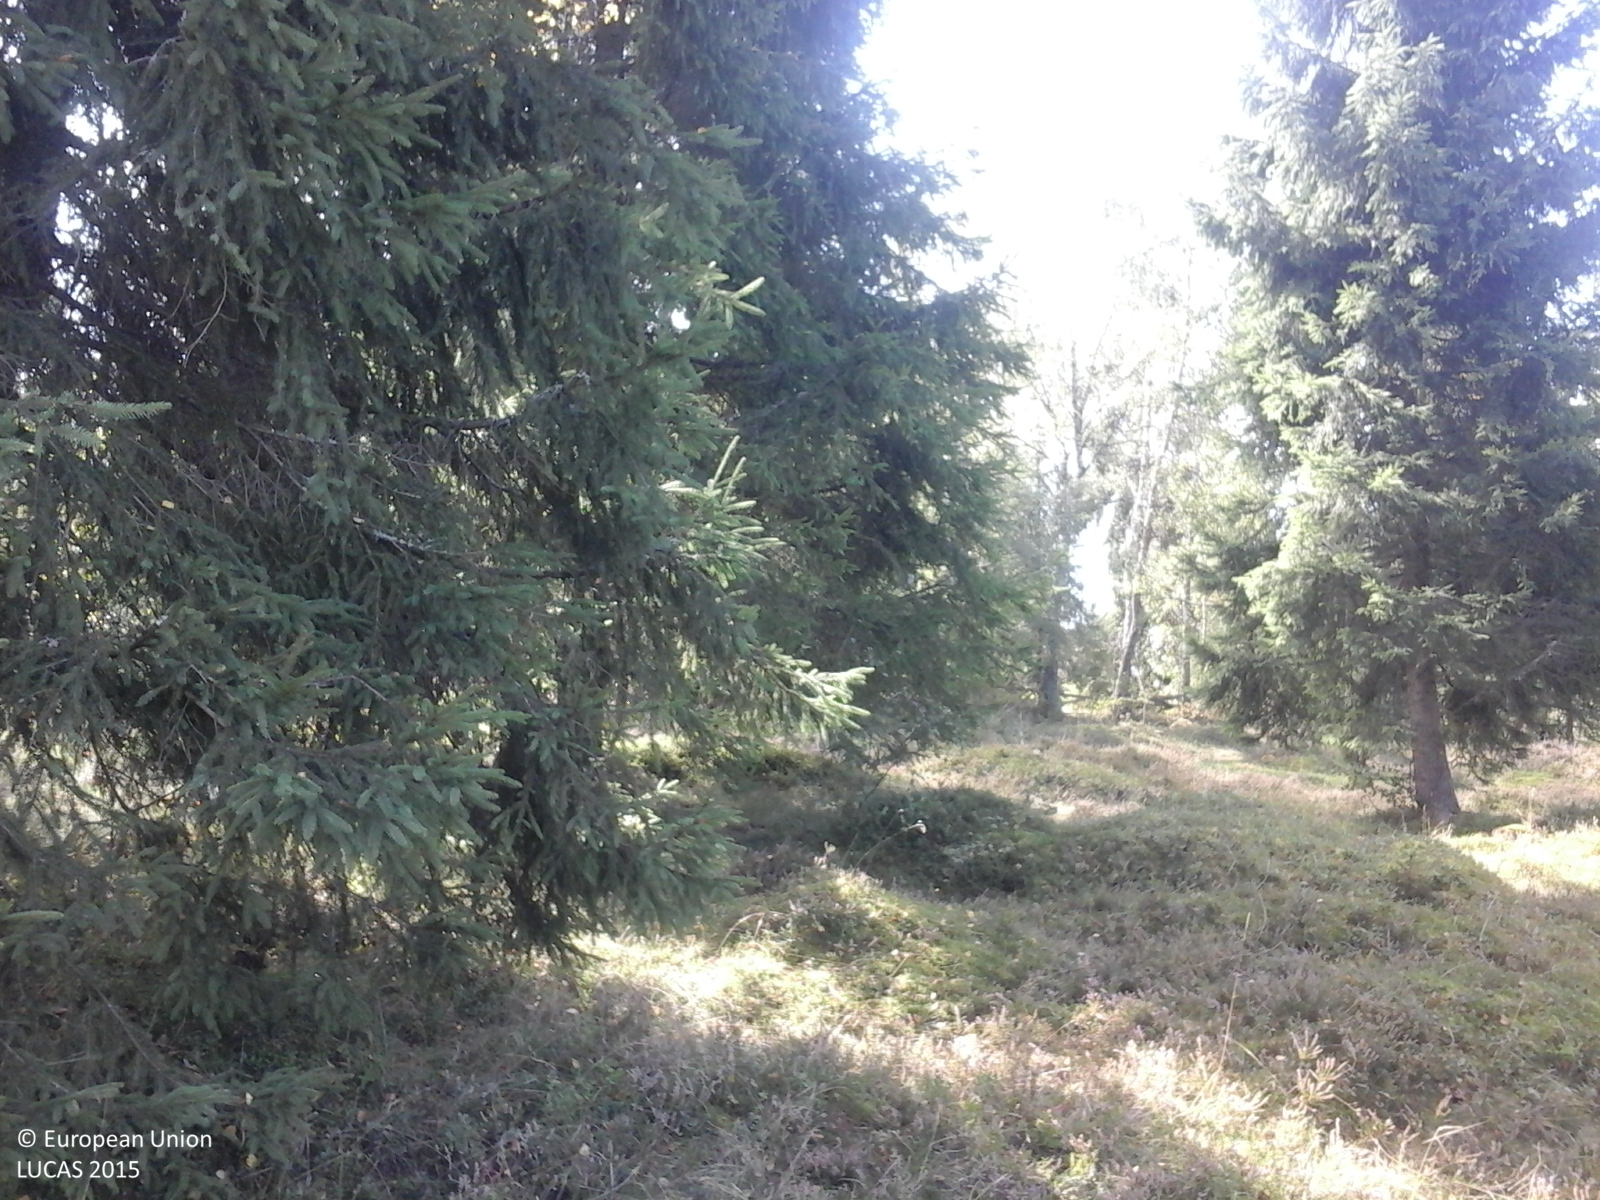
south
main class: Woodland
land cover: Spruce dominated mixed woodland
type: alpine coniferous forest
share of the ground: > 75 %
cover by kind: coniferous forest trees 50 %, broadleaved forest trees 30 %, herbaceous plants 15 %, shrubs 5 %
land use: Forestry
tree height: > 5 m
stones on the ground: < 10 %
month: September
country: RO
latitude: 46.7144
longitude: 23.0515
